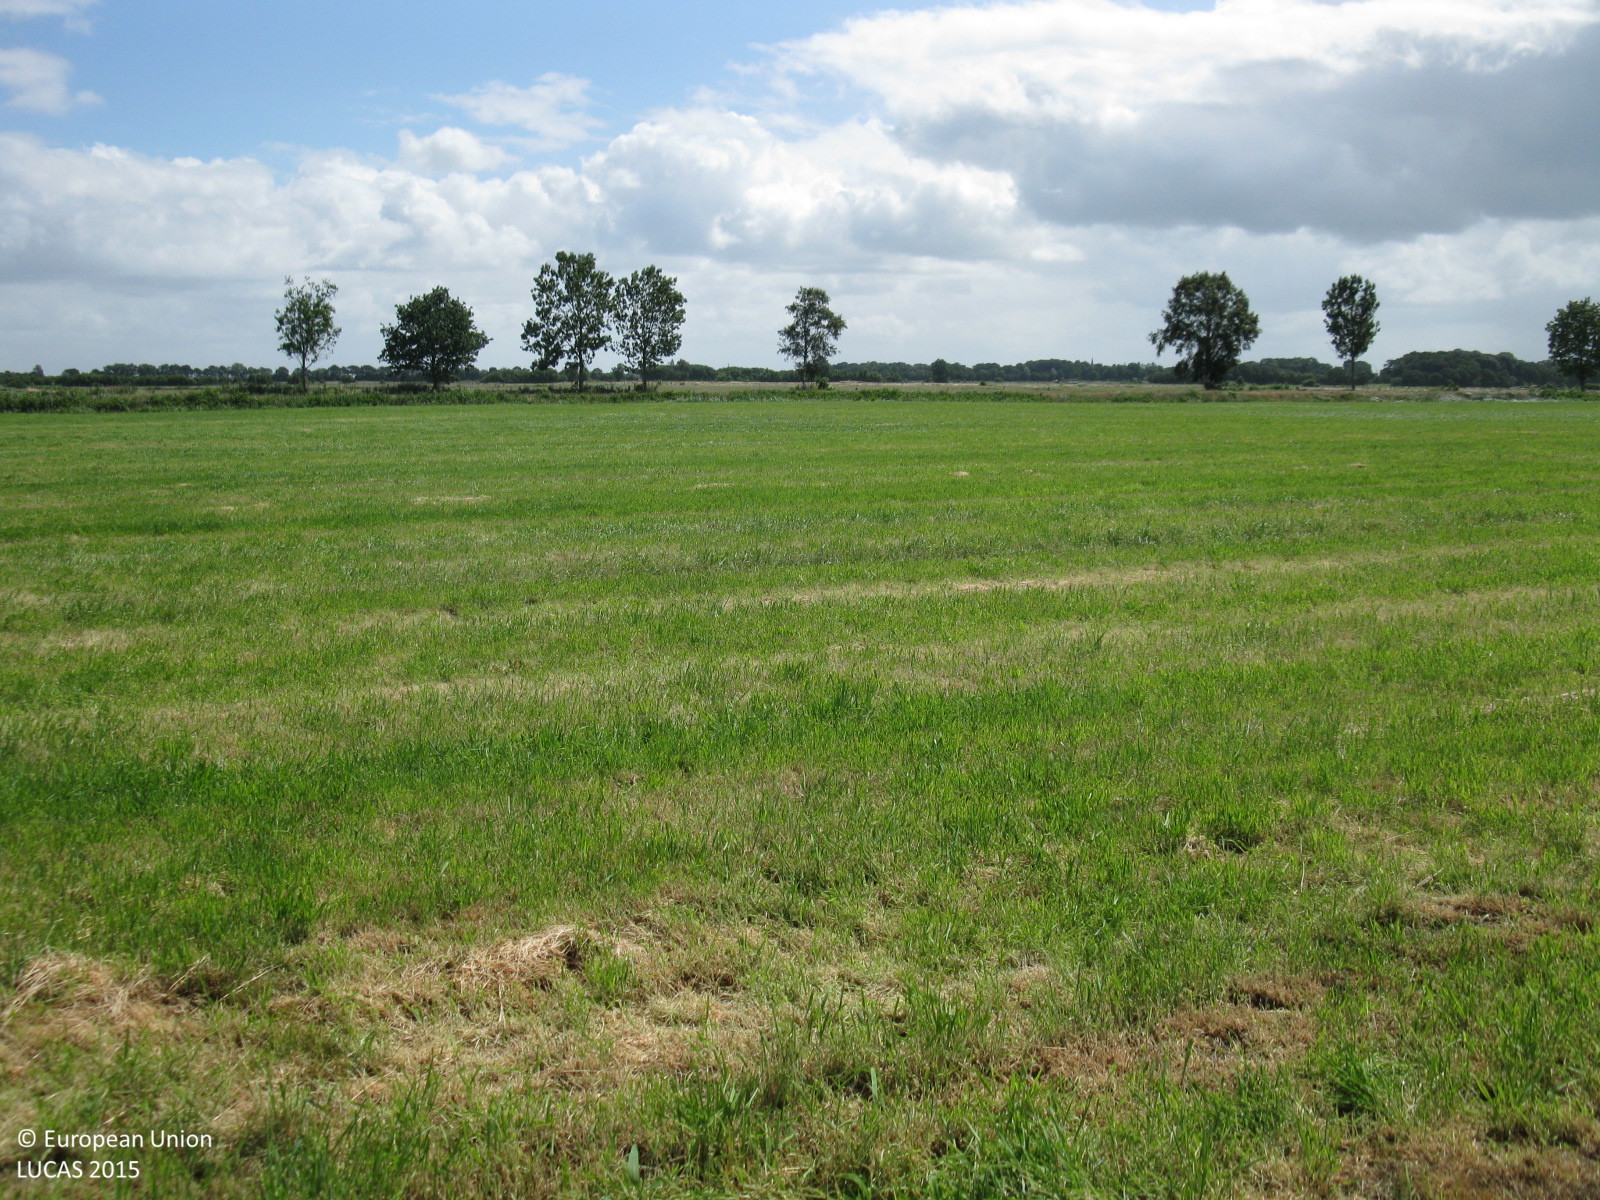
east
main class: Grassland
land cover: Grassland without tree/shrub cover
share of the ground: > 75 %
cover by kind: herbaceous plants 100 %
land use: Agriculture (excluding fallow land and kitchen gardens)
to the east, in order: Grassland without tree/shrub cover; Ditches and canals; Shruby margins; Grassland without tree/shrub cover; Paved roads, cycling and walking lanes; Grass margins; Lines of trees; Fences; Grassland without tree/shrub cover
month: July
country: DE
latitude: 53.4732
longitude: 7.8764
